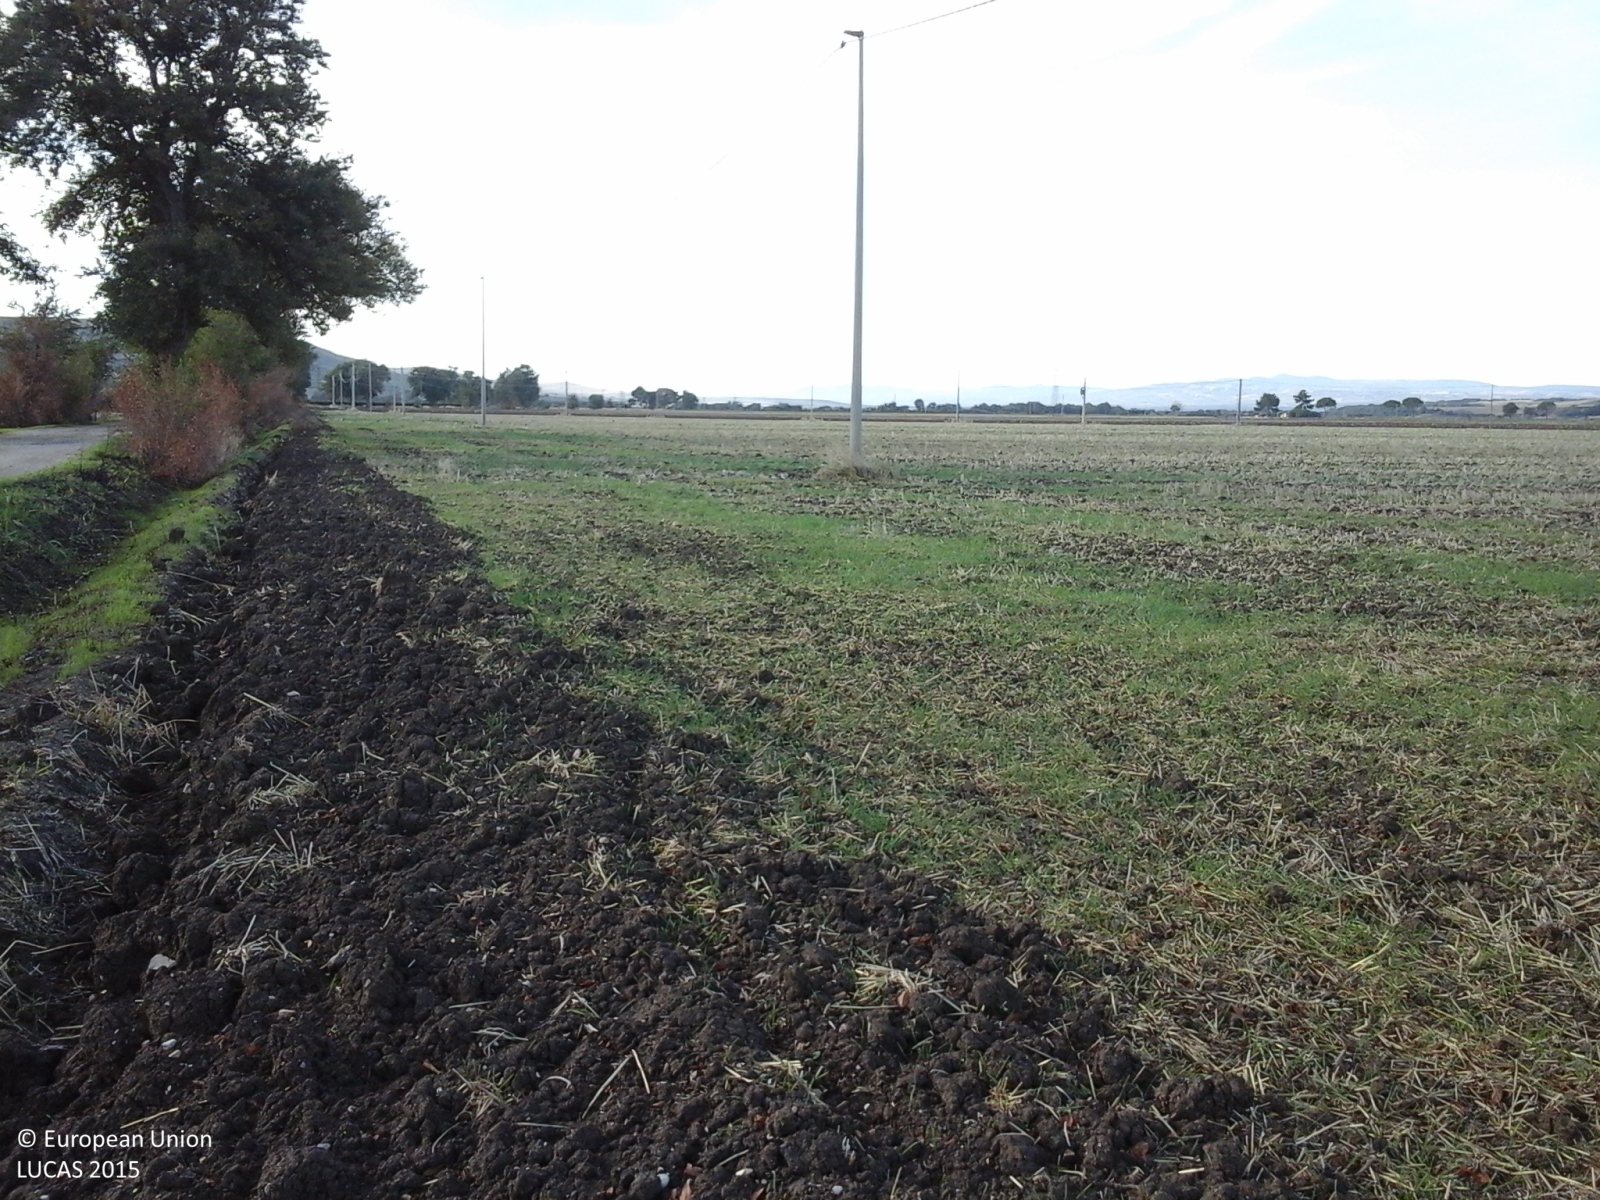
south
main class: Cropland
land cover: Durum wheat
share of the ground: > 75 %
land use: Agriculture (excluding fallow land and kitchen gardens)
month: October
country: IT
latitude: 41.7955
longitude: 15.2187
